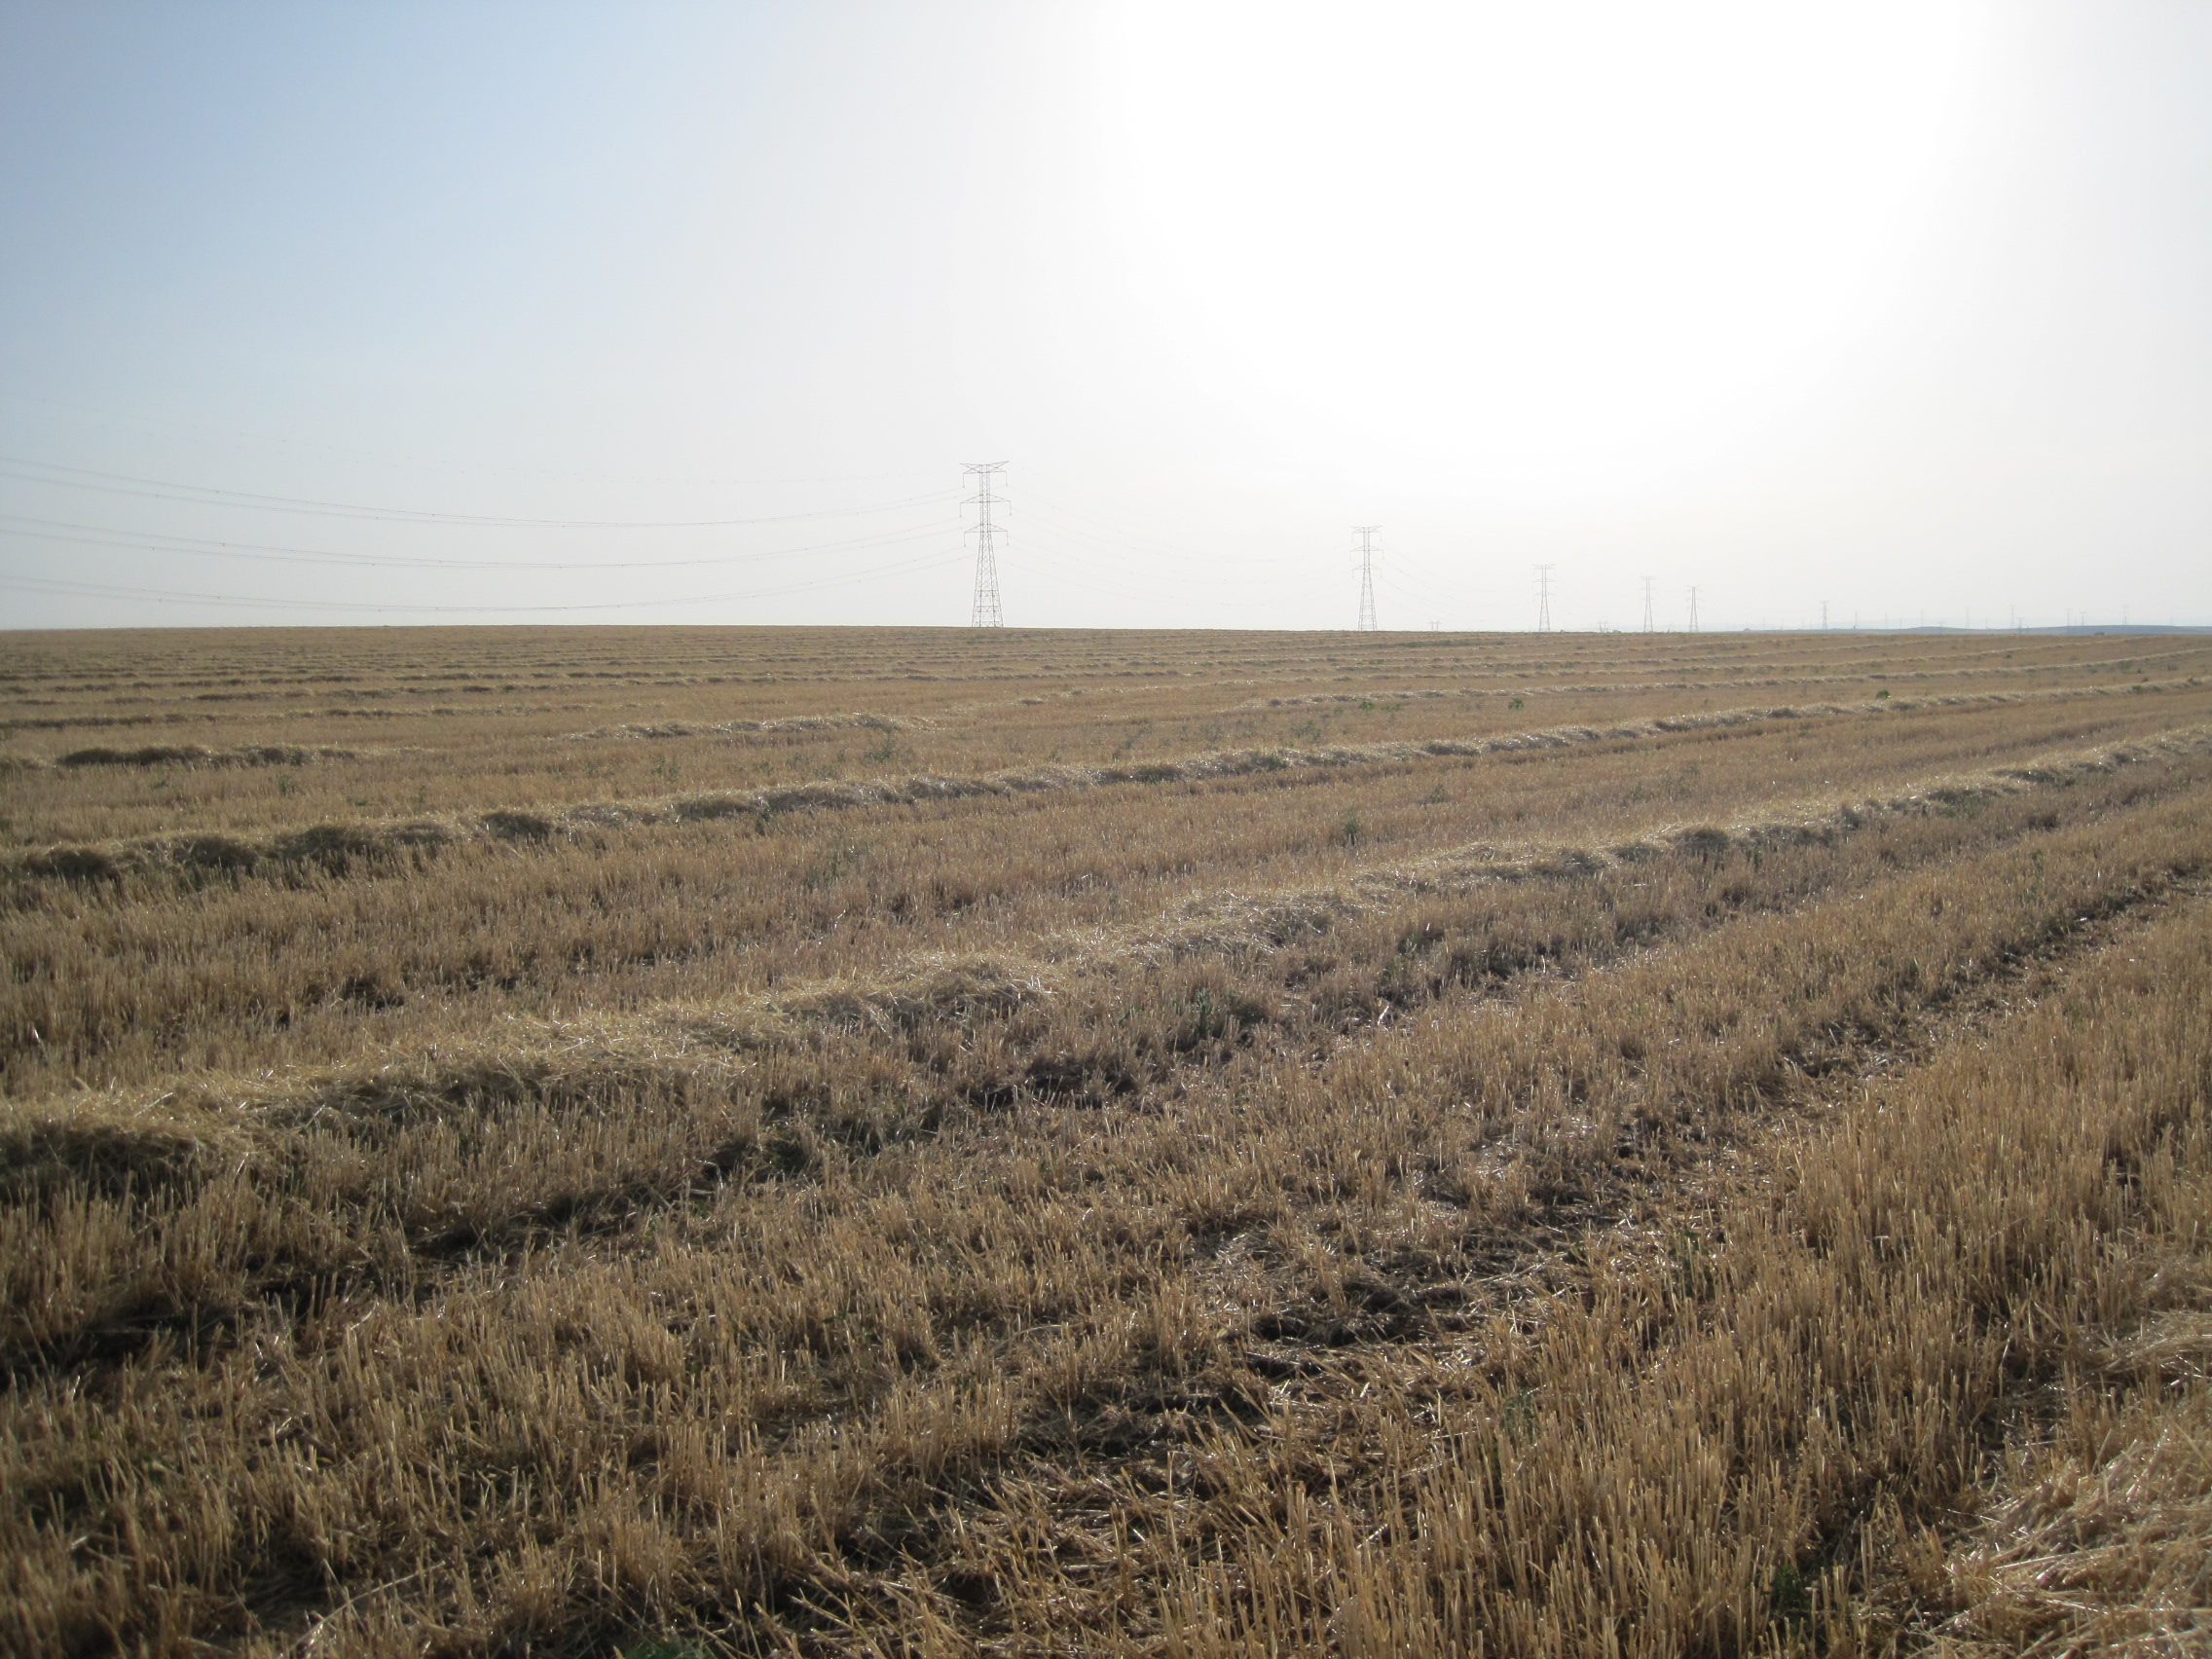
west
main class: Cropland
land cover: Barley
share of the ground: < 10 %
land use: Agriculture (excluding fallow land and kitchen gardens)
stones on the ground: 25 - 50 %
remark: Harvested field
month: July
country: ES
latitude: 41.6662
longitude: -5.5417
